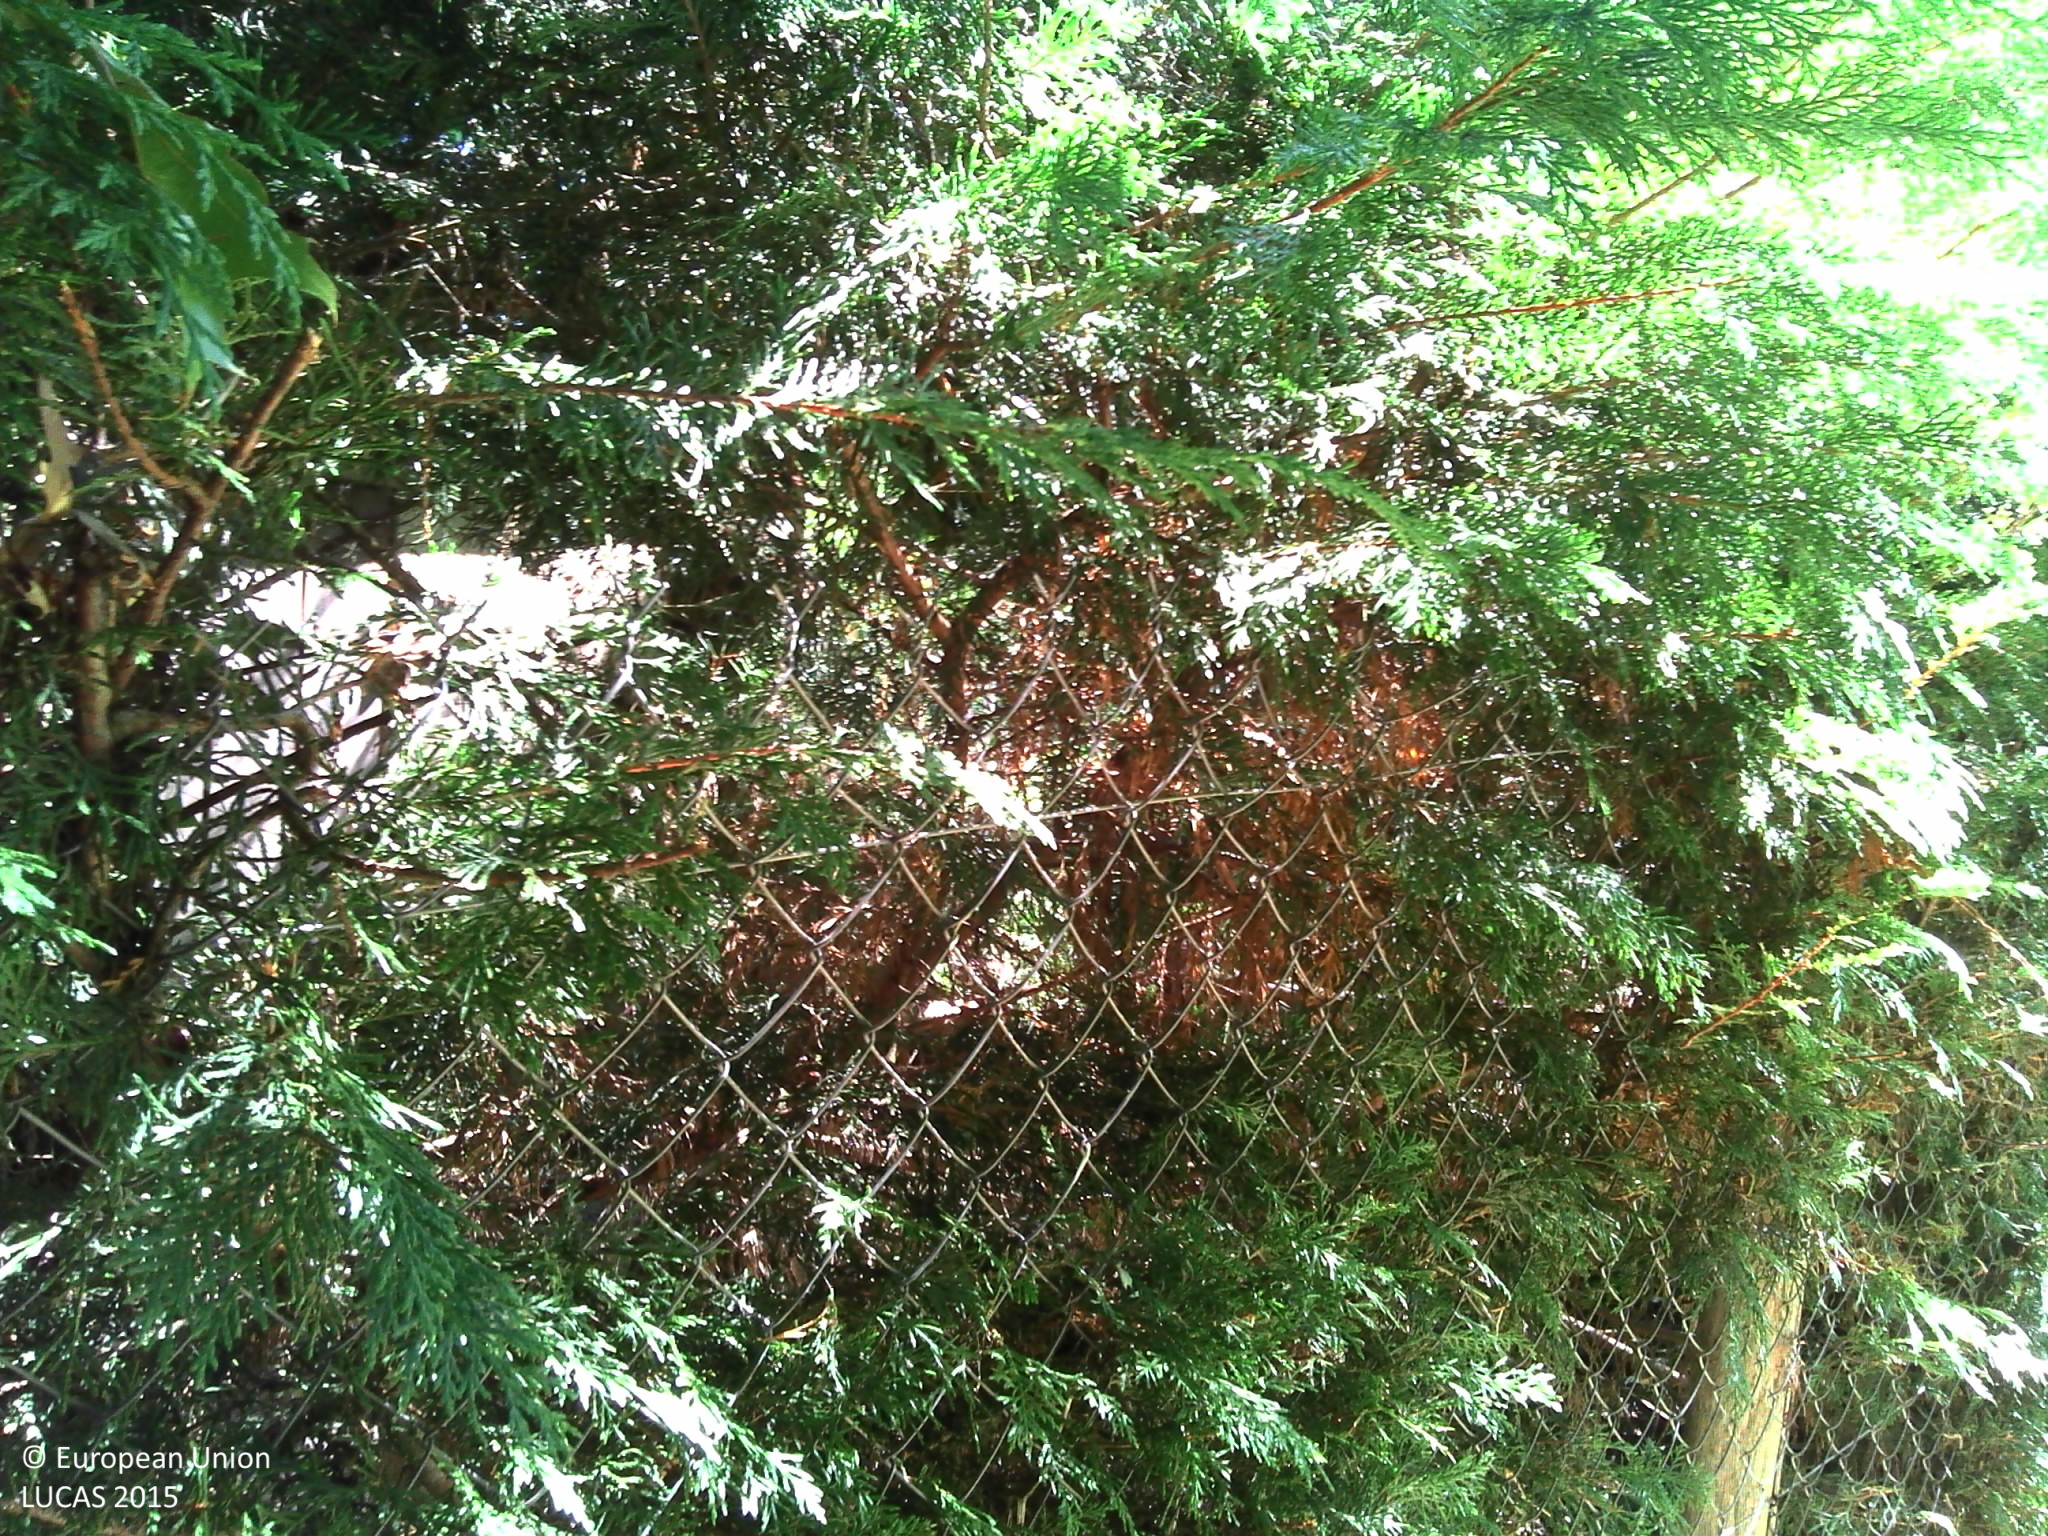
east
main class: Grassland
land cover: Grassland with sparse tree/shrub cover
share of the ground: > 75 %
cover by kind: herbaceous plants 95 %, broadleaved forest trees 5 %
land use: Residential
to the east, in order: Conifer hedges; Grassland with sparse tree/shrub cover; Artificial constructions in urban areas; Grassland with sparse tree/shrub cover; Fences; Broadleaved woodland; Fences; Artificial constructions in urban areas; Maize; Grassland with sparse tree/shrub cover; Tracks; Grass margins; Electric lines; Fences; Grassland with sparse tree/shrub cover
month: August
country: FR
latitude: 45.2584
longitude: 0.5201
